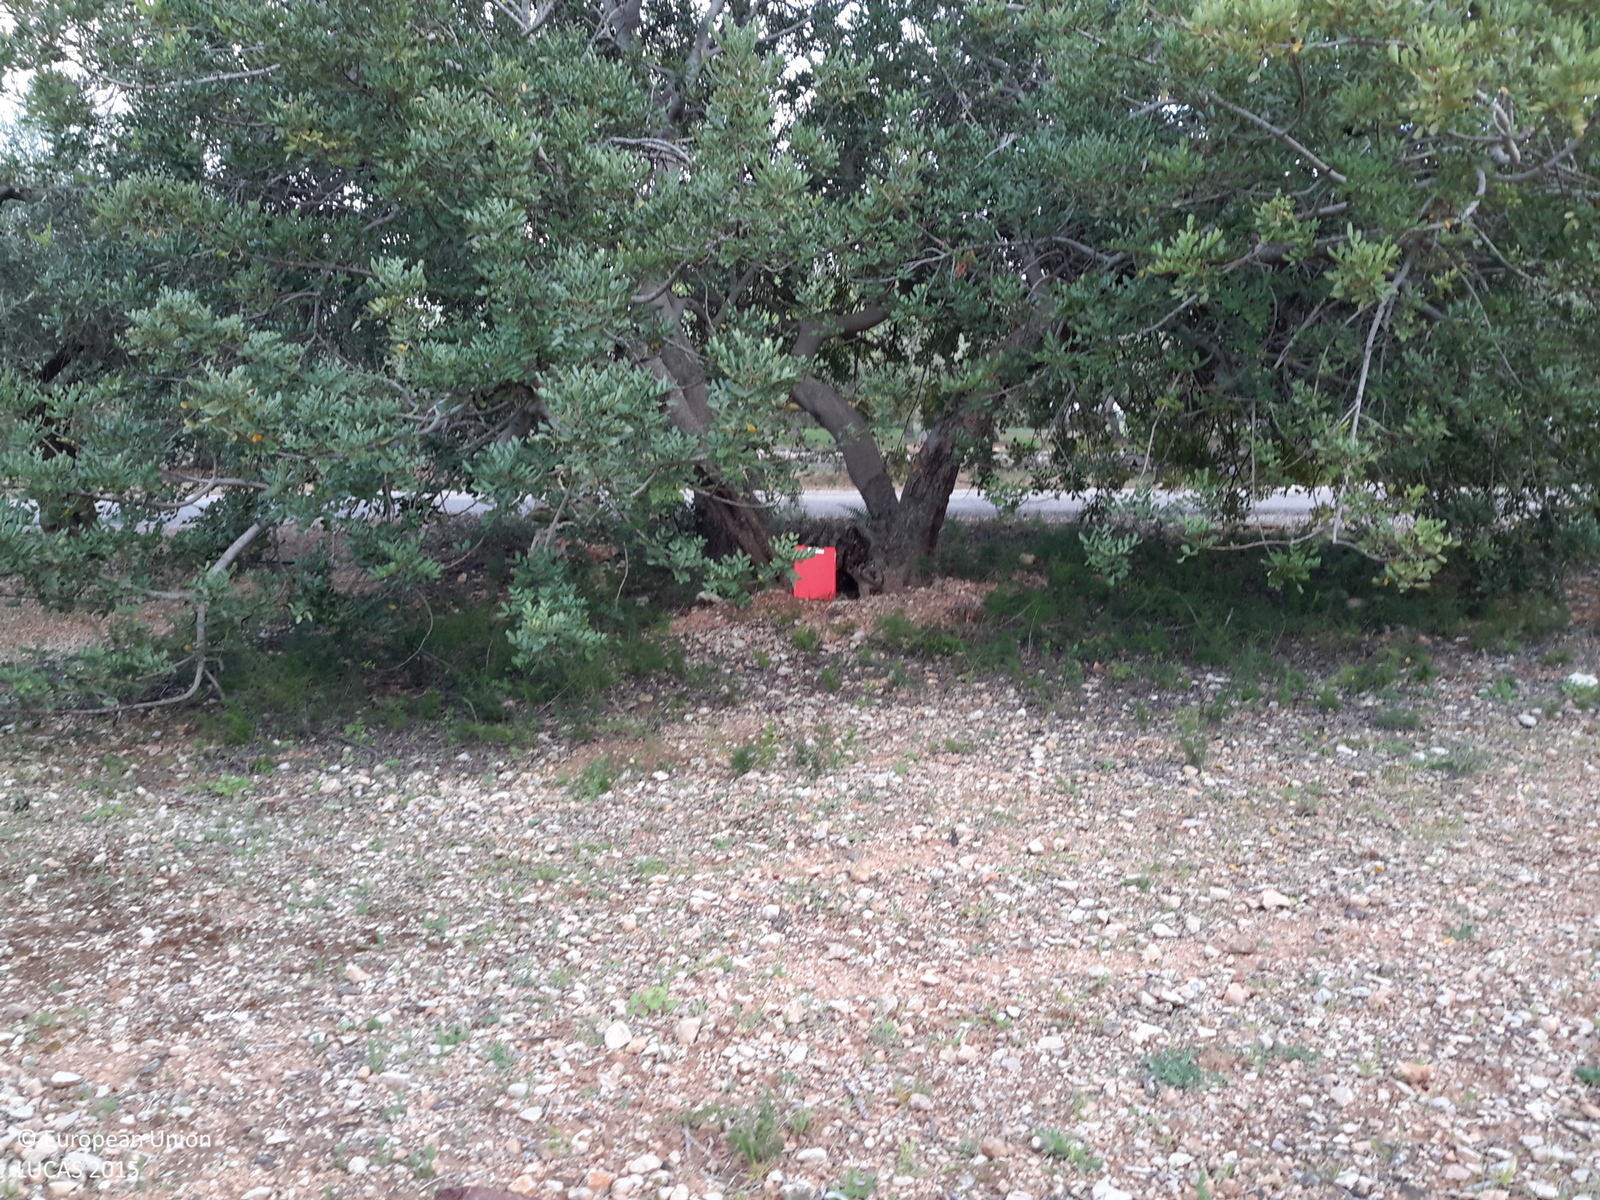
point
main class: Cropland
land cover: Olive groves
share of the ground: 25 - 50 %
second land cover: Spontaneously vegetated surfaces
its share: 25 - 50 %
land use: Agriculture (excluding fallow land and kitchen gardens)
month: April
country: ES
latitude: 40.6315
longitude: 0.5727
